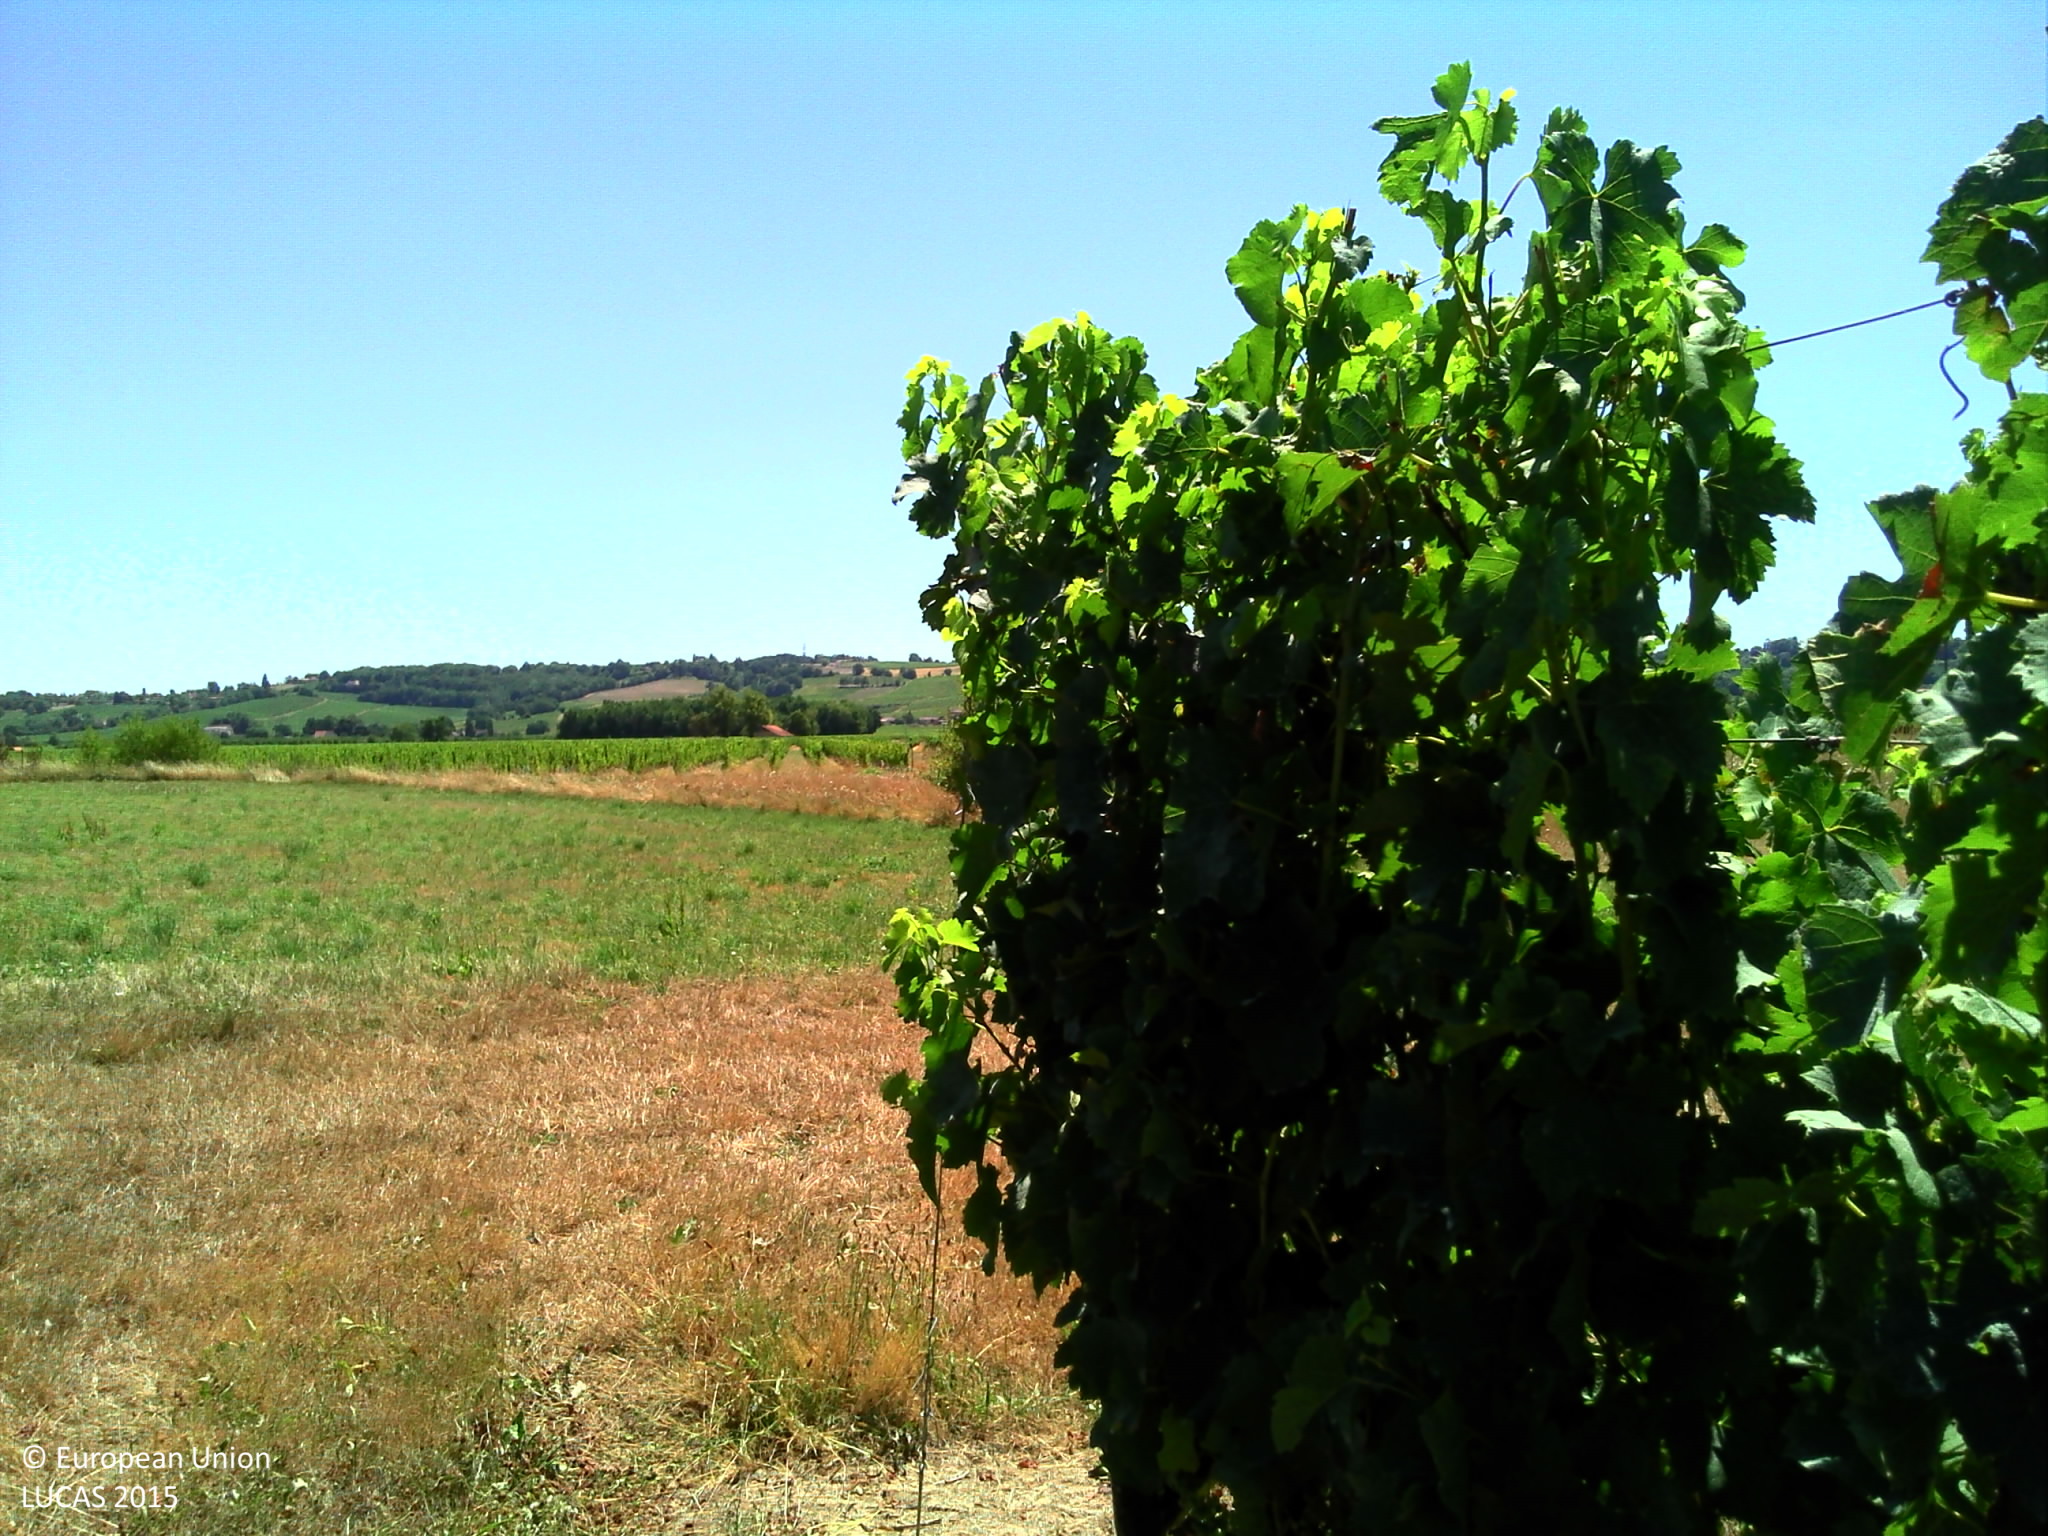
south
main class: Cropland
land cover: Vineyards
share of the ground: 25 - 50 %
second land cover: Grassland without tree/shrub cover
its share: > 75 %
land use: Agriculture (excluding fallow land and kitchen gardens)
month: July
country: FR
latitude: 44.8205
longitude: 0.4929
